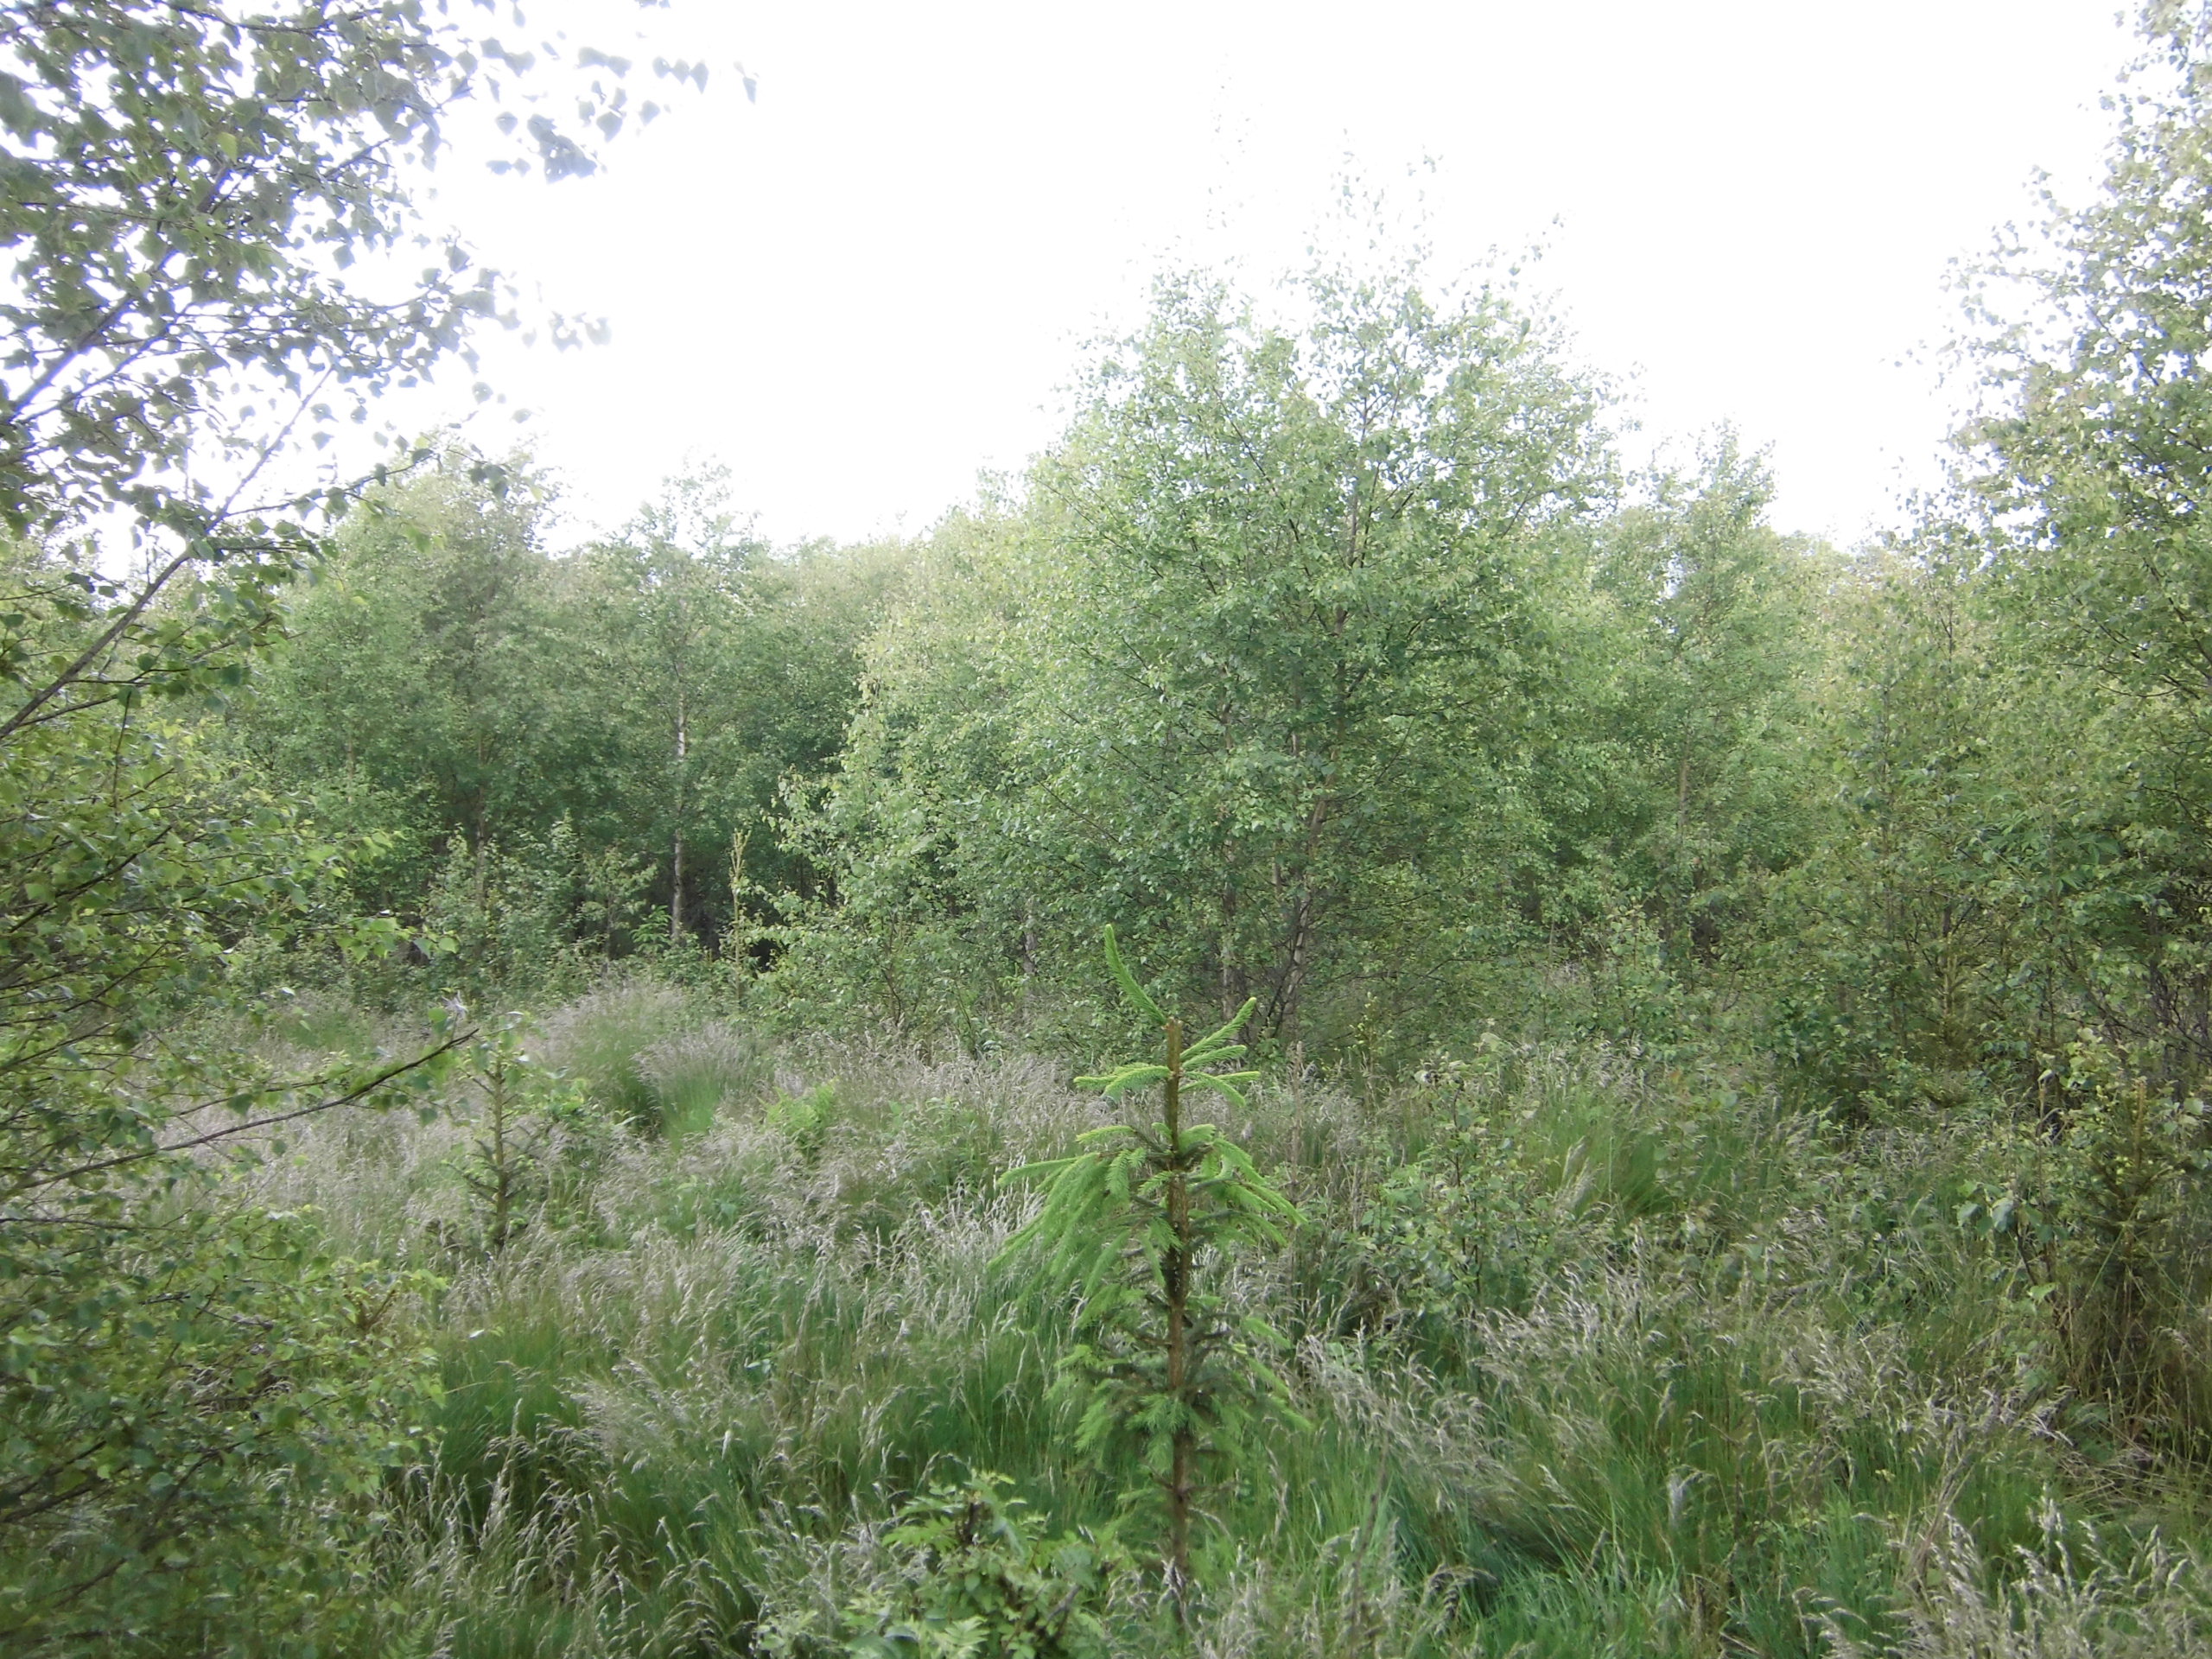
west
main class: Woodland
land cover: Broadleaved woodland
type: boreal forest
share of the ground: 50 - 75 %
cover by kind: broadleaved forest trees 60 %, herbaceous plants 15 %, coniferous forest trees 10 %, shrubs 10 %, lichens and mosses 5 %
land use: Forestry
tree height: < 5 m
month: June
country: SE
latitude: 57.0768
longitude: 14.6321
